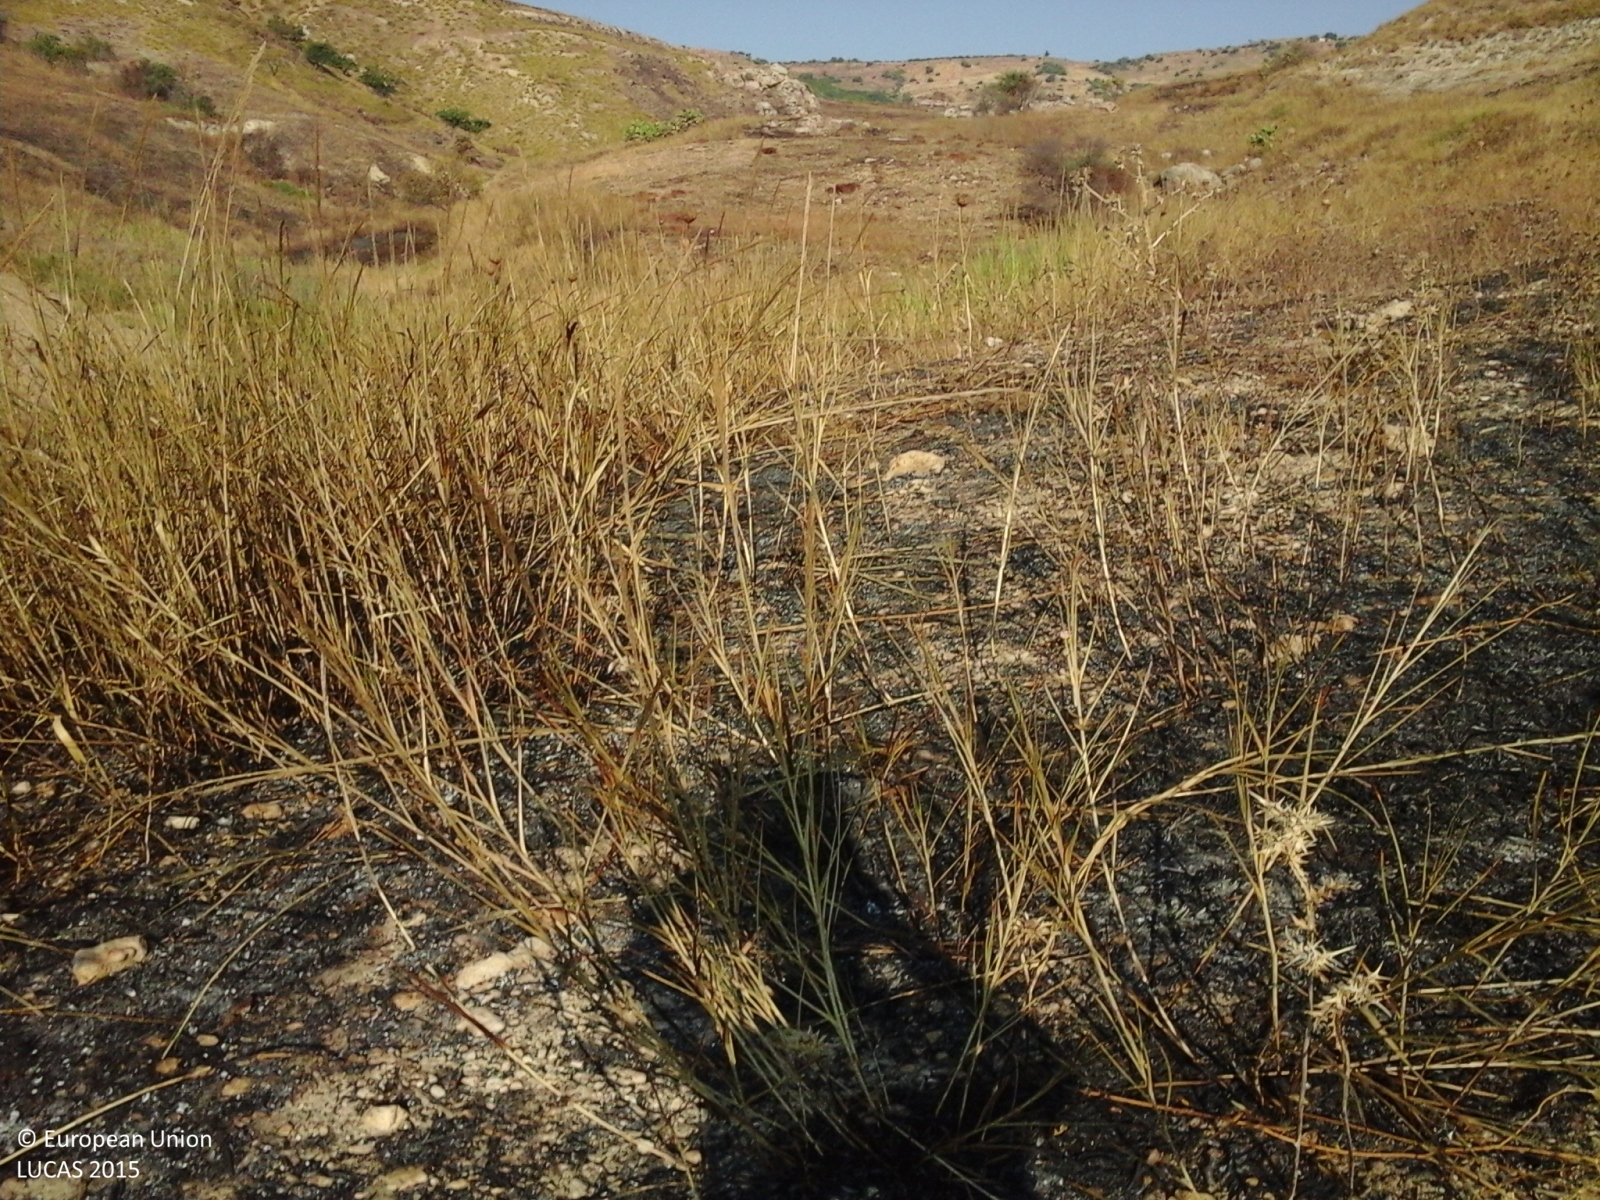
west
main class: Grassland
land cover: Grassland without tree/shrub cover
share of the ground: > 75 %
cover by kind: herbaceous plants 100 %
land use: Agriculture (excluding fallow land and kitchen gardens)
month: July
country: IT
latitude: 37.2456
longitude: 13.9935
